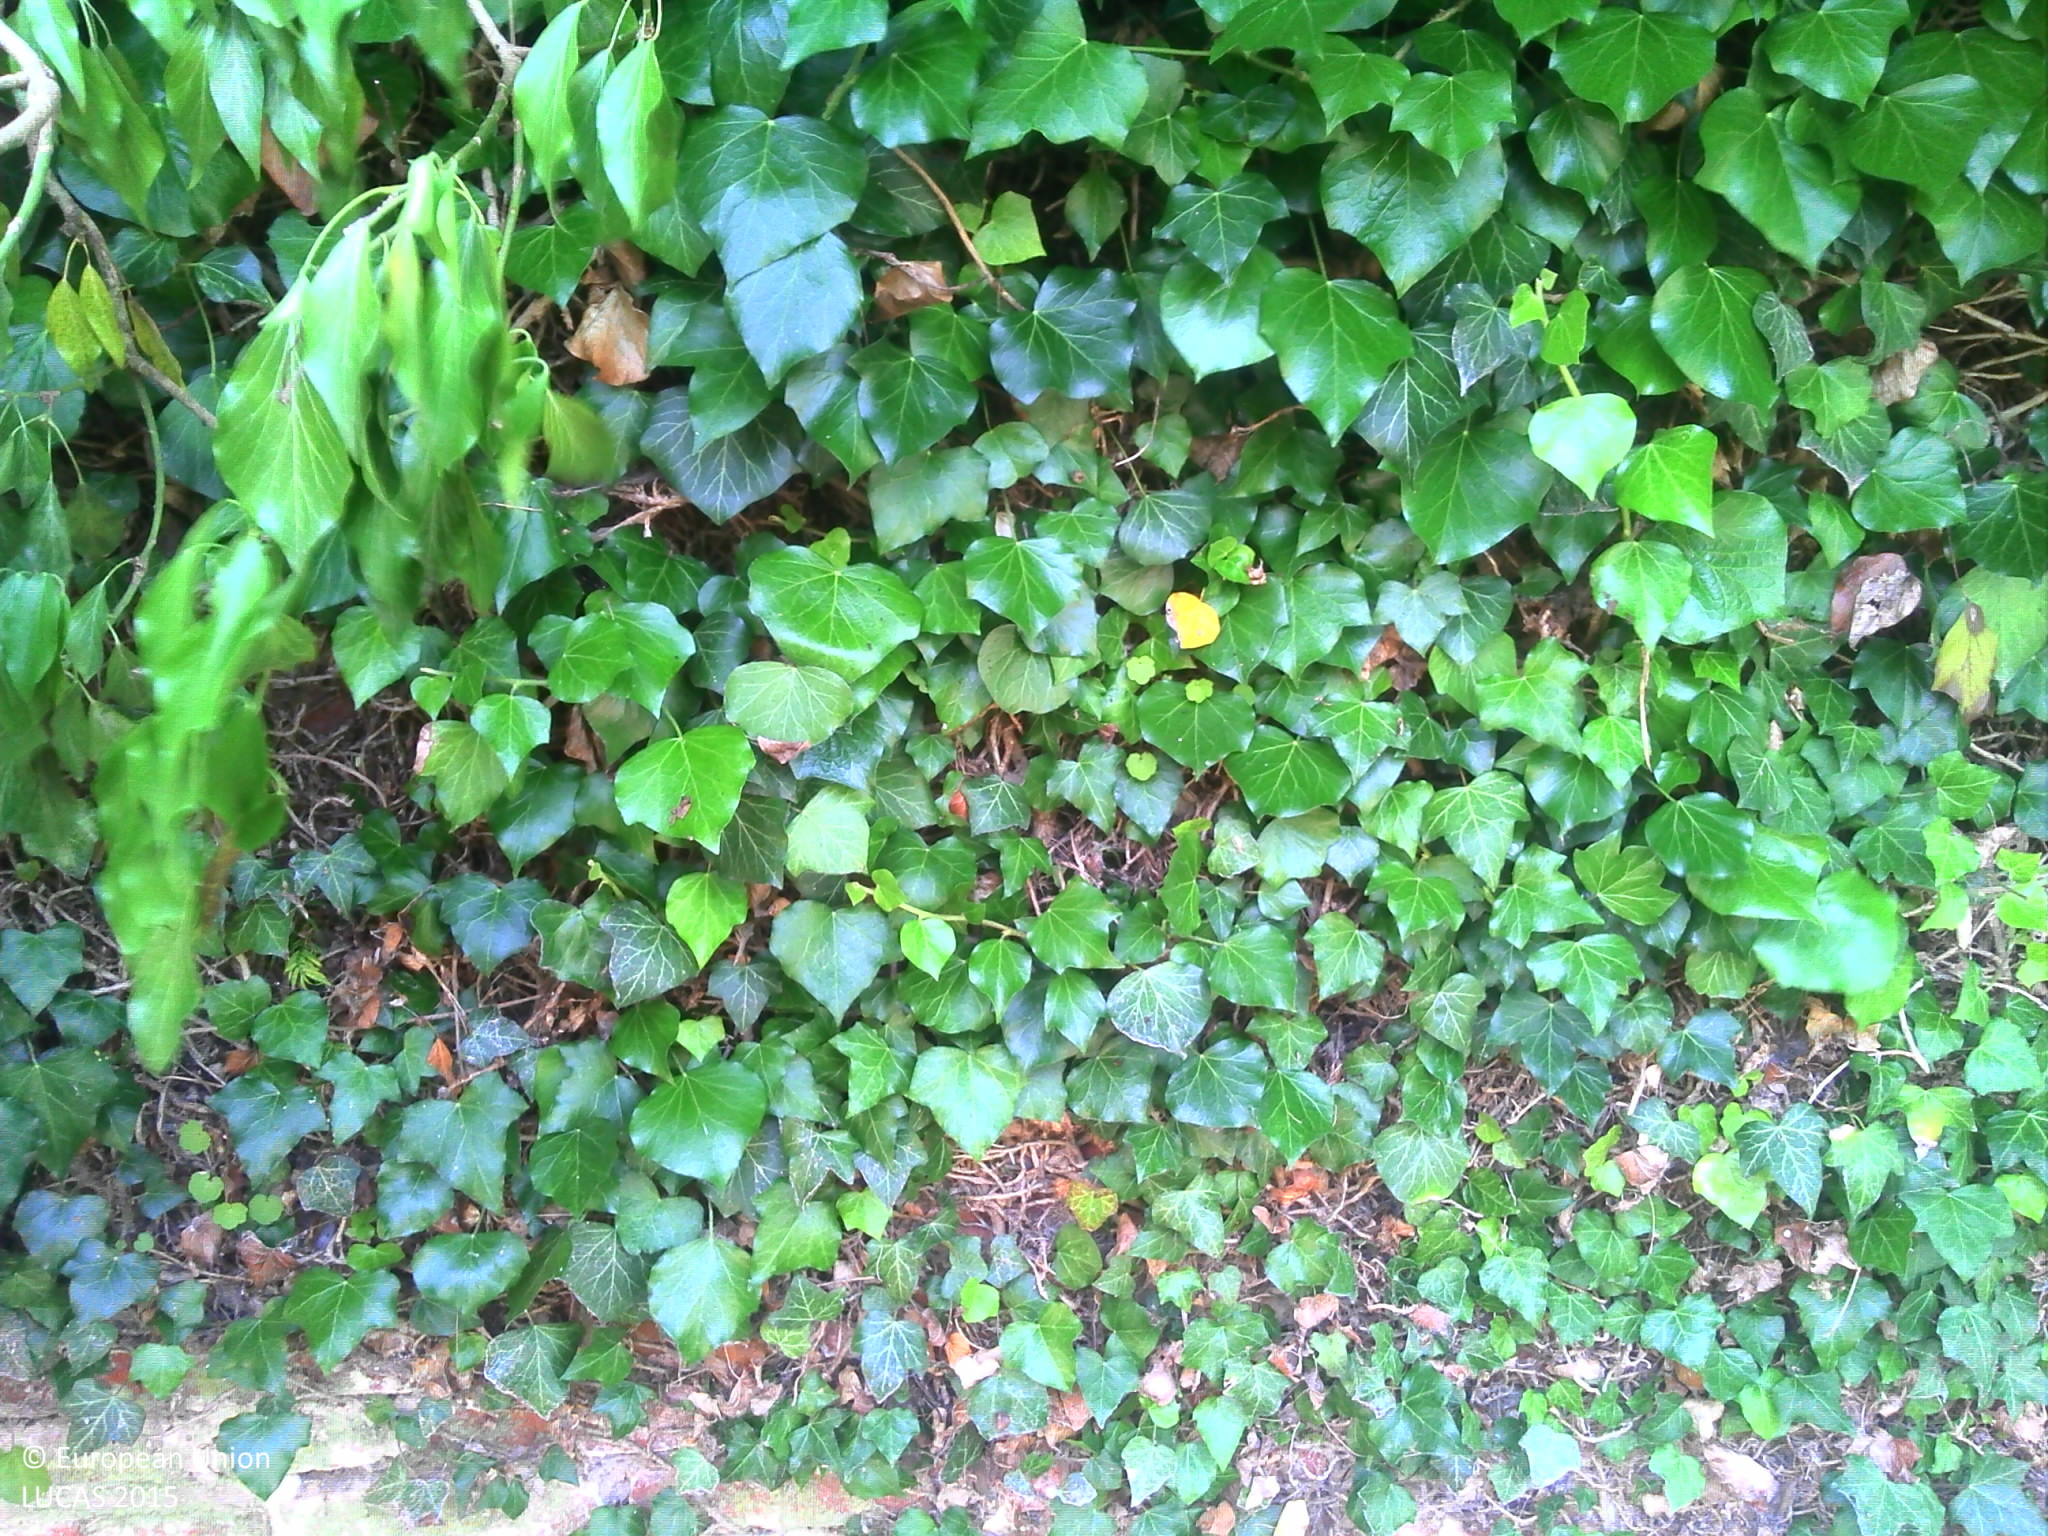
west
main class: Grassland
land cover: Grassland with sparse tree/shrub cover
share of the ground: > 75 %
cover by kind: herbaceous plants 90 %, broadleaved forest trees 5 %, shrubs 5 %
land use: Residential
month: June
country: FR
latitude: 49.7084
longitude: 4.1292
